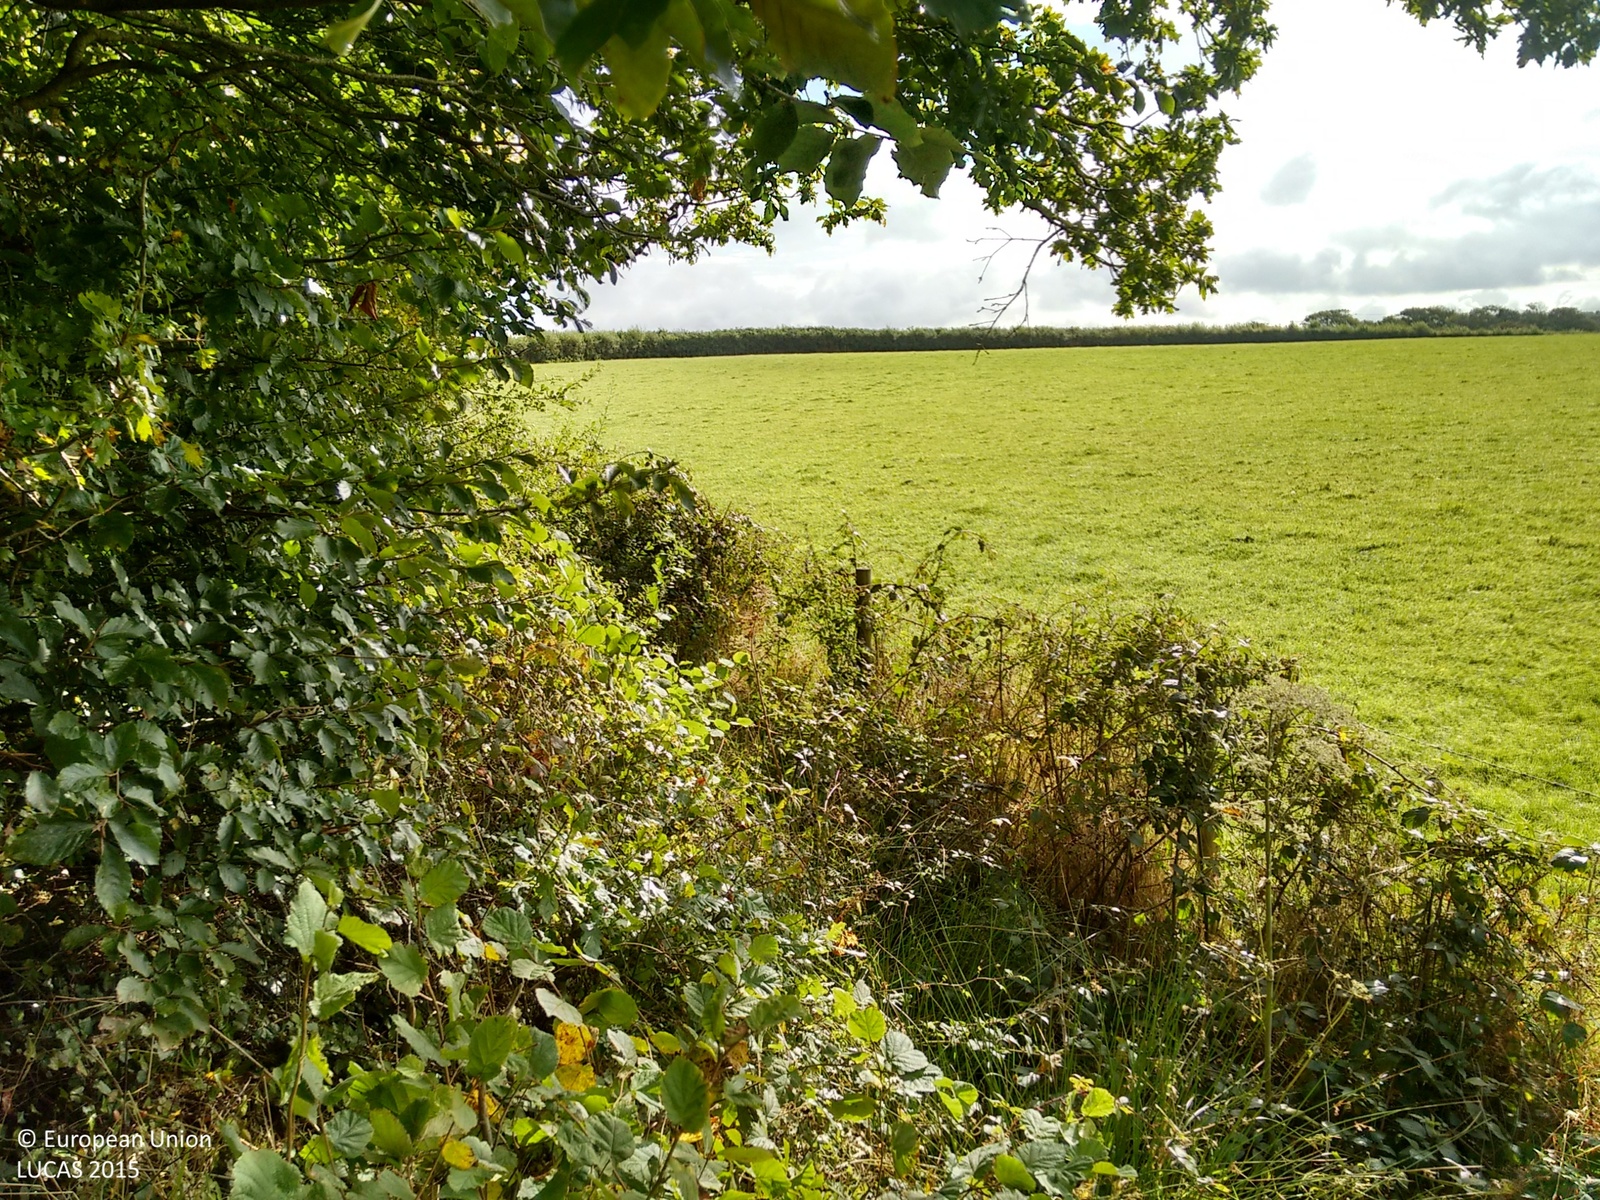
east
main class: Grassland
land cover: Grassland without tree/shrub cover
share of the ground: > 75 %
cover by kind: herbaceous plants 100 %
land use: Agriculture (excluding fallow land and kitchen gardens)
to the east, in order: Grassland without tree/shrub cover; Fences; Managed hedges; Fences; Grassland without tree/shrub cover; Fences; Managed hedges; Fences; Grassland without tree/shrub cover
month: September
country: GB
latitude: 50.8244
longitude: -4.1949
